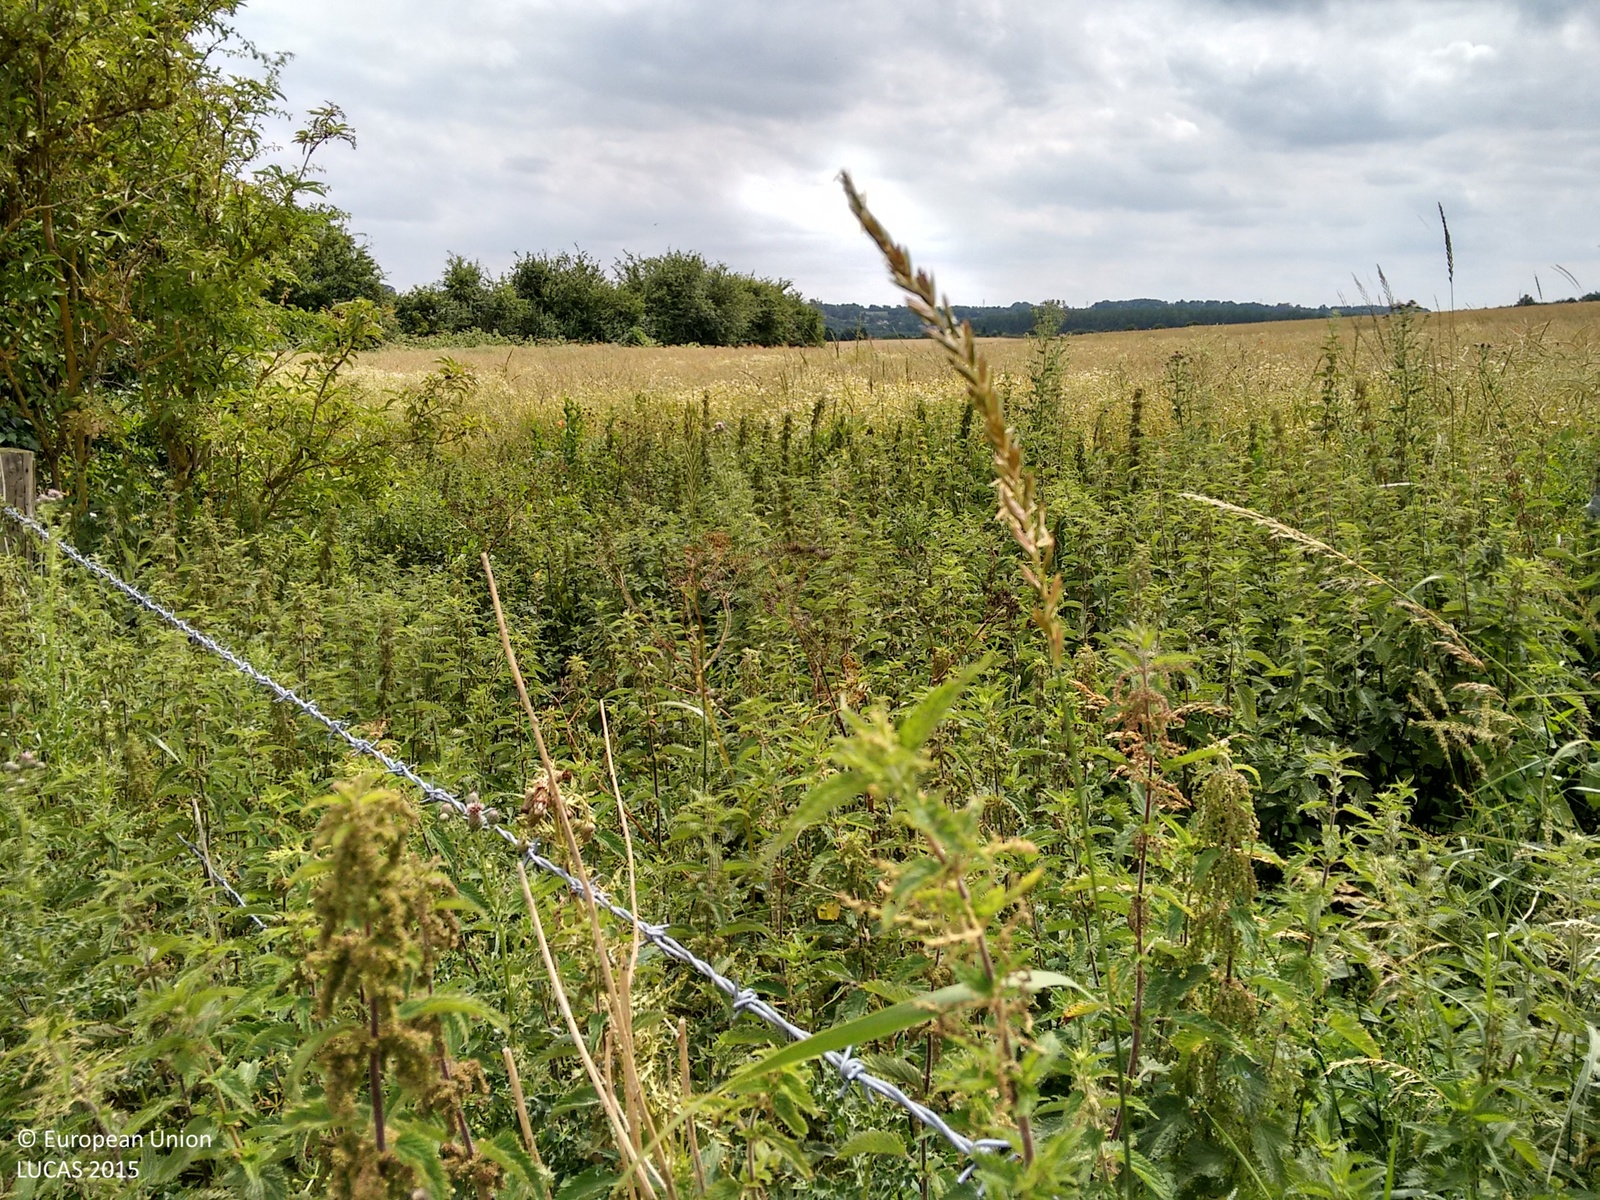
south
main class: Cropland
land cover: Rape and turnip rape
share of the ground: > 75 %
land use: Agriculture (excluding fallow land and kitchen gardens)
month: July
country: GB
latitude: 52.5222
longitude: -0.7558
